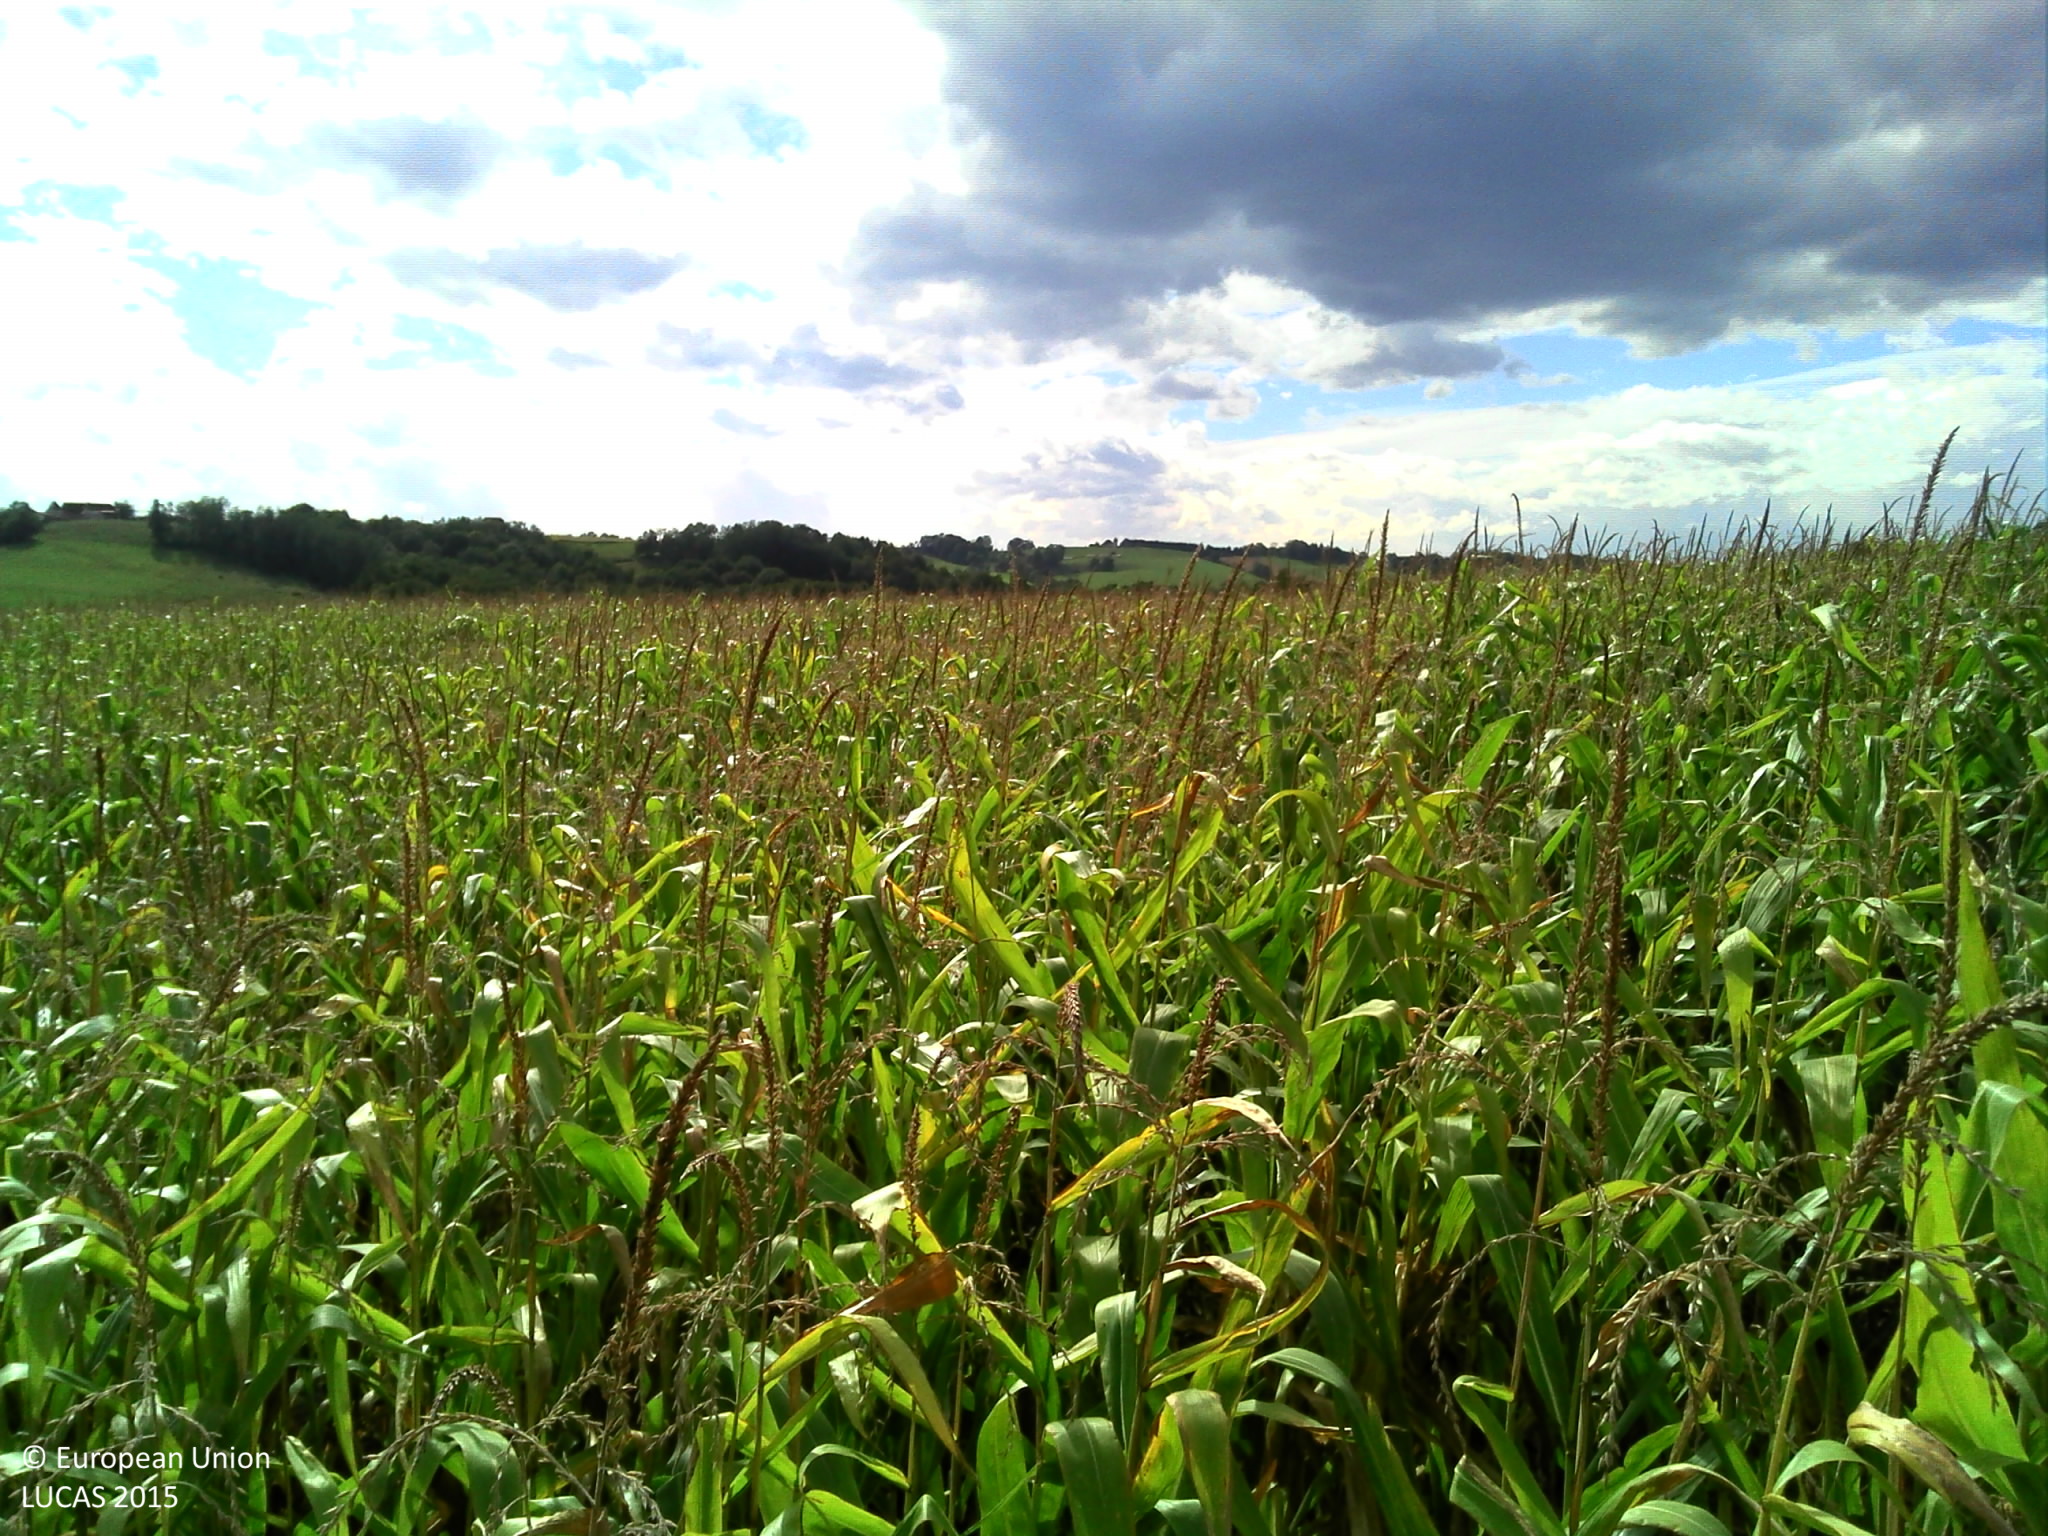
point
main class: Cropland
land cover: Maize
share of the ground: > 75 %
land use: Agriculture (excluding fallow land and kitchen gardens)
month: September
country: FR
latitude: 43.3993
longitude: -0.6654
